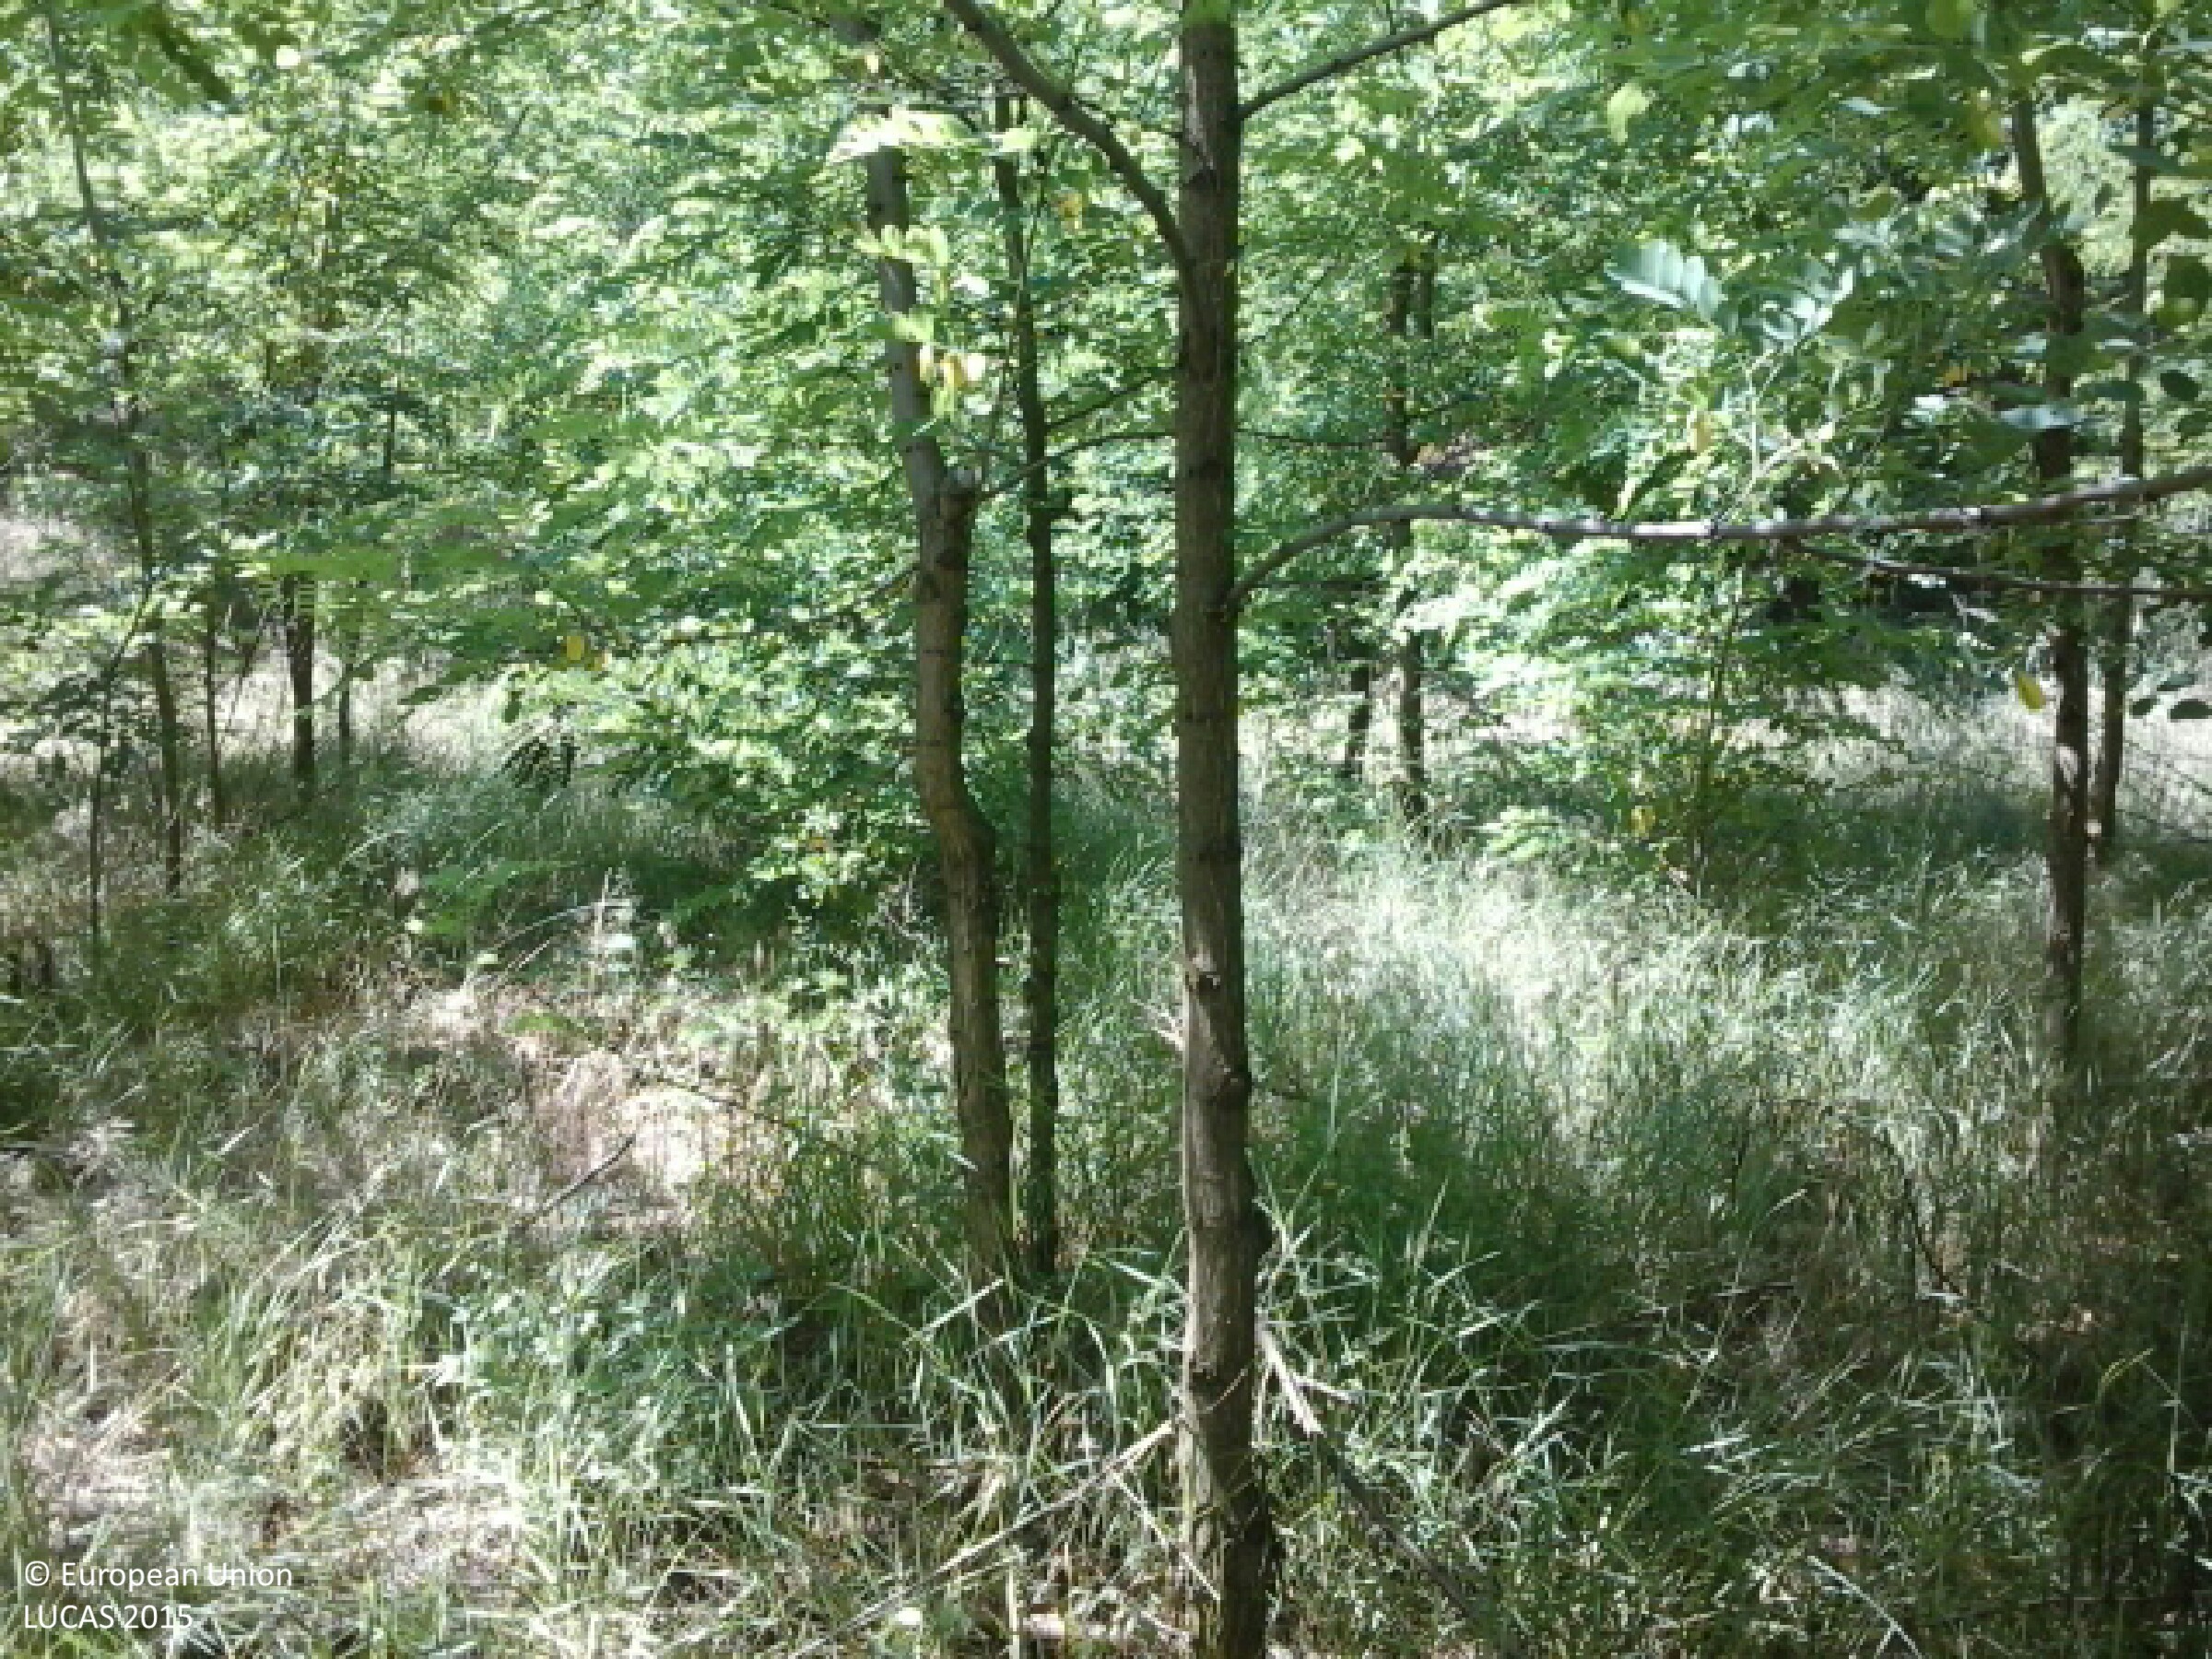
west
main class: Woodland
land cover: Broadleaved woodland
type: exotic forest
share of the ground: > 75 %
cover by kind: broadleaved forest trees 90 %, herbaceous plants 10 %
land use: Forestry
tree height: < 5 m
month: July
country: HU
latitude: 48.0055
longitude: 22.2943
